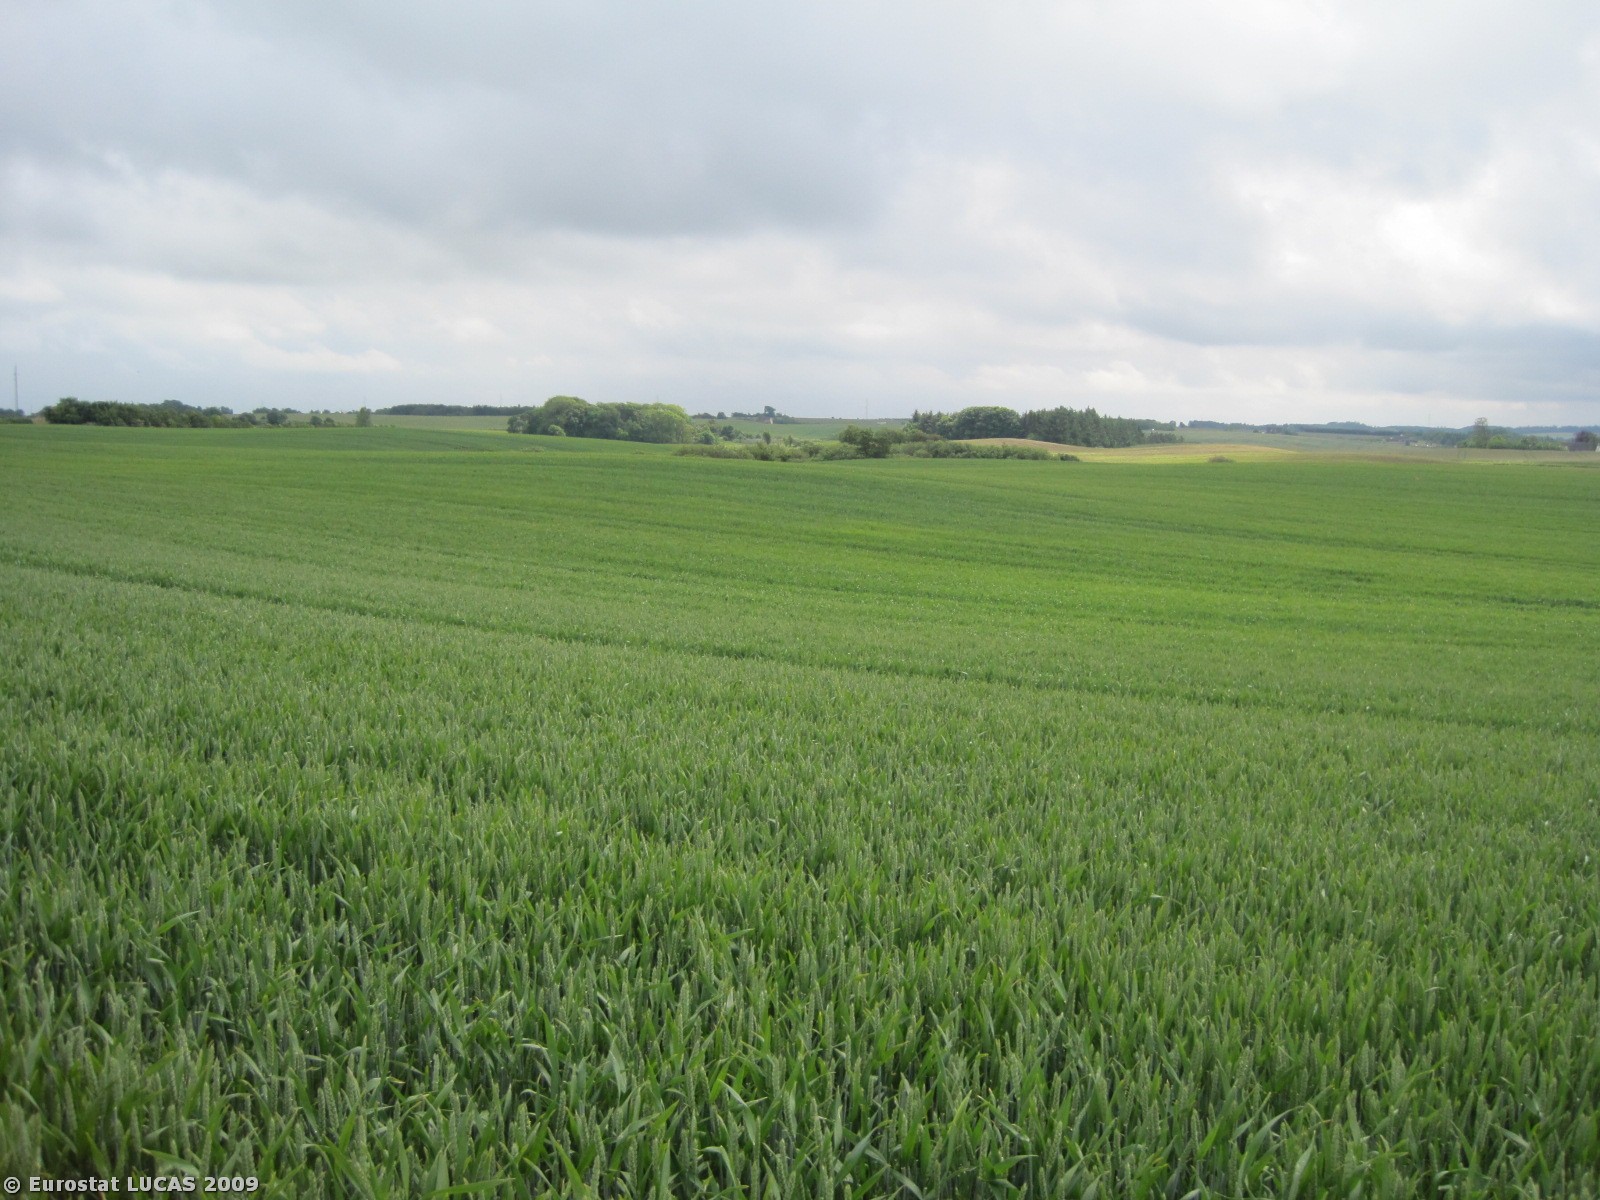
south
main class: Cropland
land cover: Common wheat
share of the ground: > 75 %
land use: Agriculture (excluding fallow land and kitchen gardens)
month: June
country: DK
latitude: 57.3561
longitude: 10.2489
